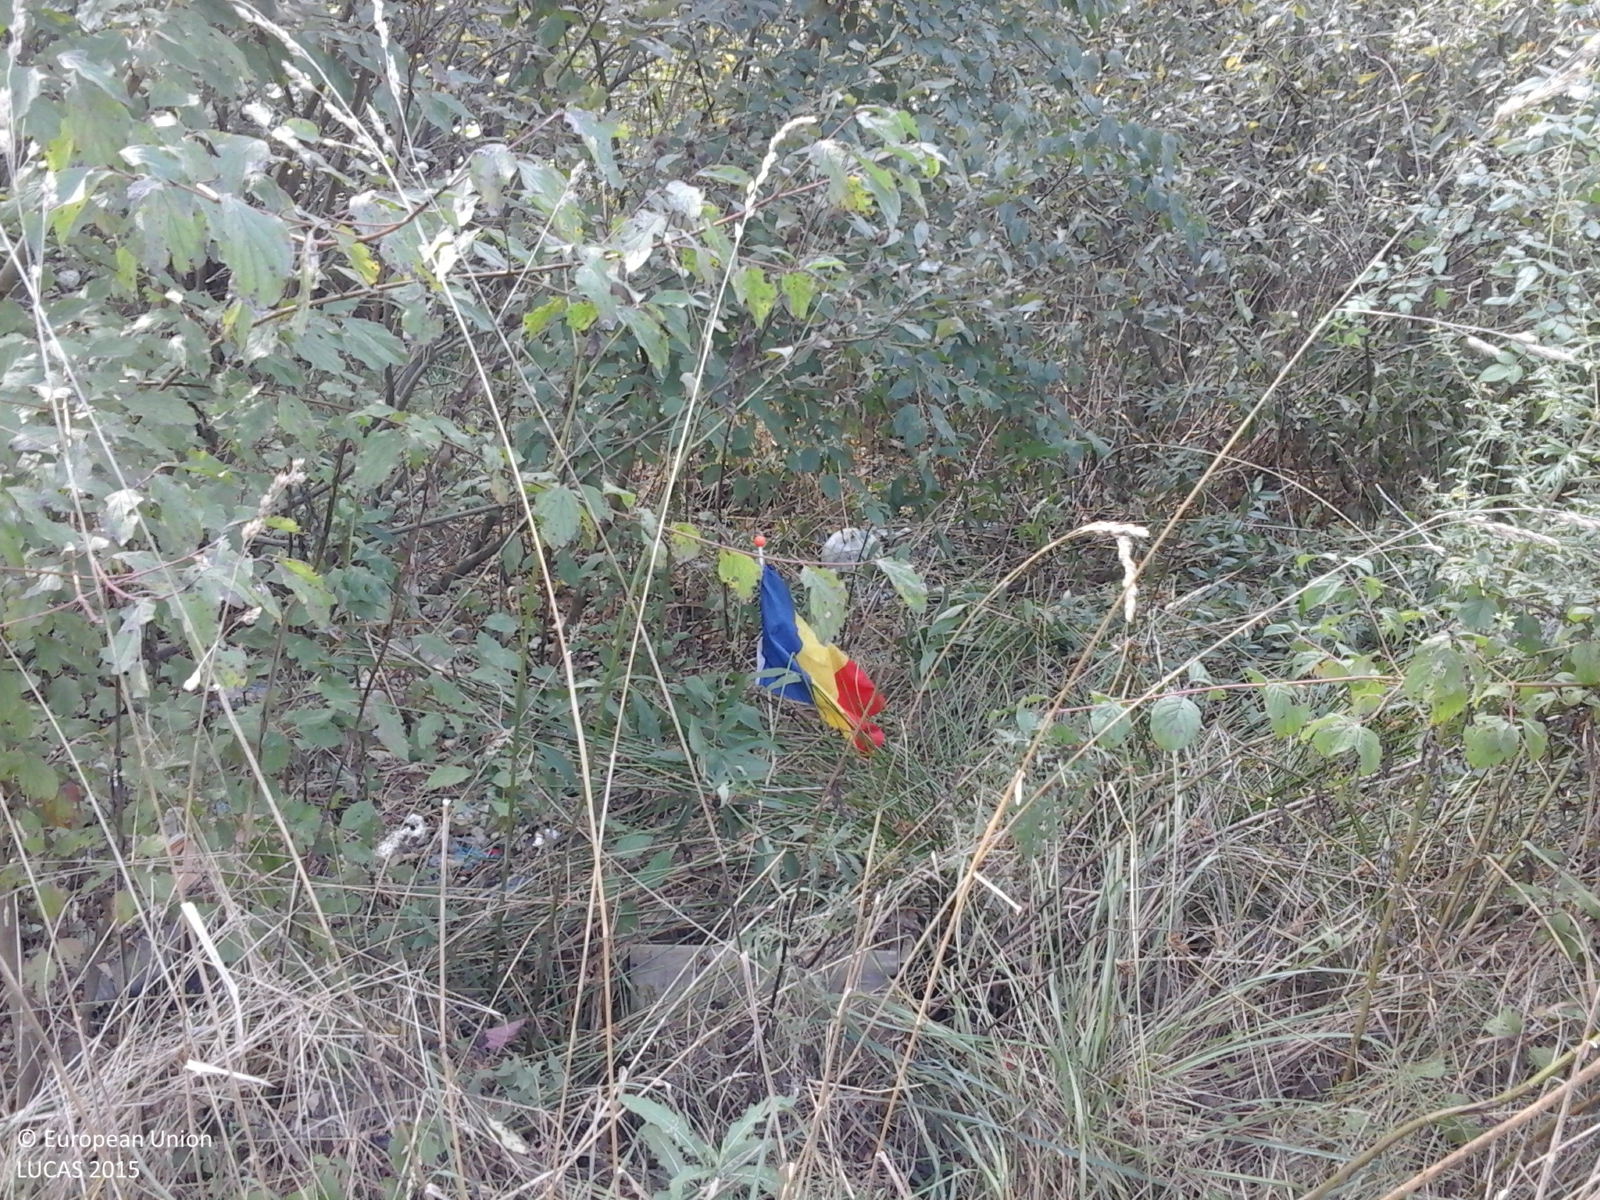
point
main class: Woodland
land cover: Broadleaved woodland
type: non-riverine alder, birch or aspen forest
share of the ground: > 75 %
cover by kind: broadleaved forest trees 100 %
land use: Semi-natural and natural areas not in use
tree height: < 5 m
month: September
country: RO
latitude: 45.5086
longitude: 22.1619
